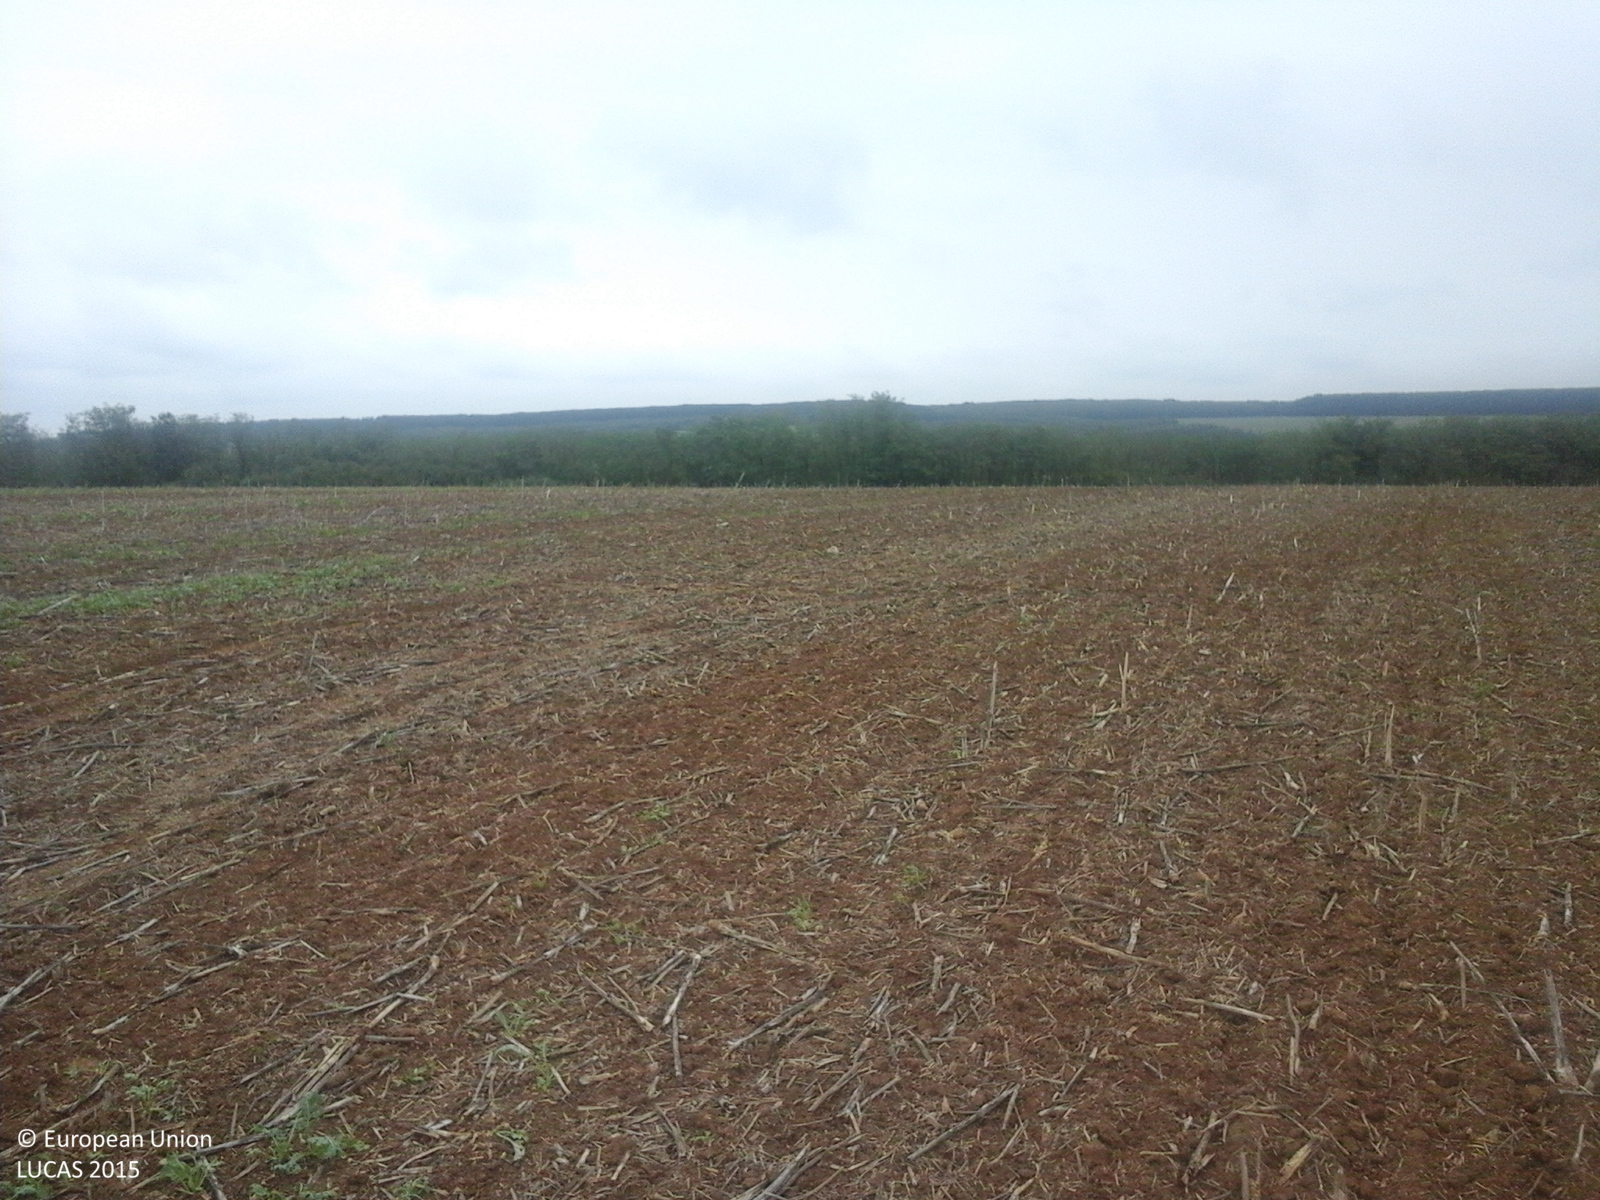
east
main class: Cropland
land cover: Rape and turnip rape
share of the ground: < 10 %
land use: Agriculture (excluding fallow land and kitchen gardens)
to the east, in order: Rape and turnip rape; Tracks; Rape and turnip rape; Broadleaved woodland
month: September
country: RO
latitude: 47.2849
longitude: 22.0677
